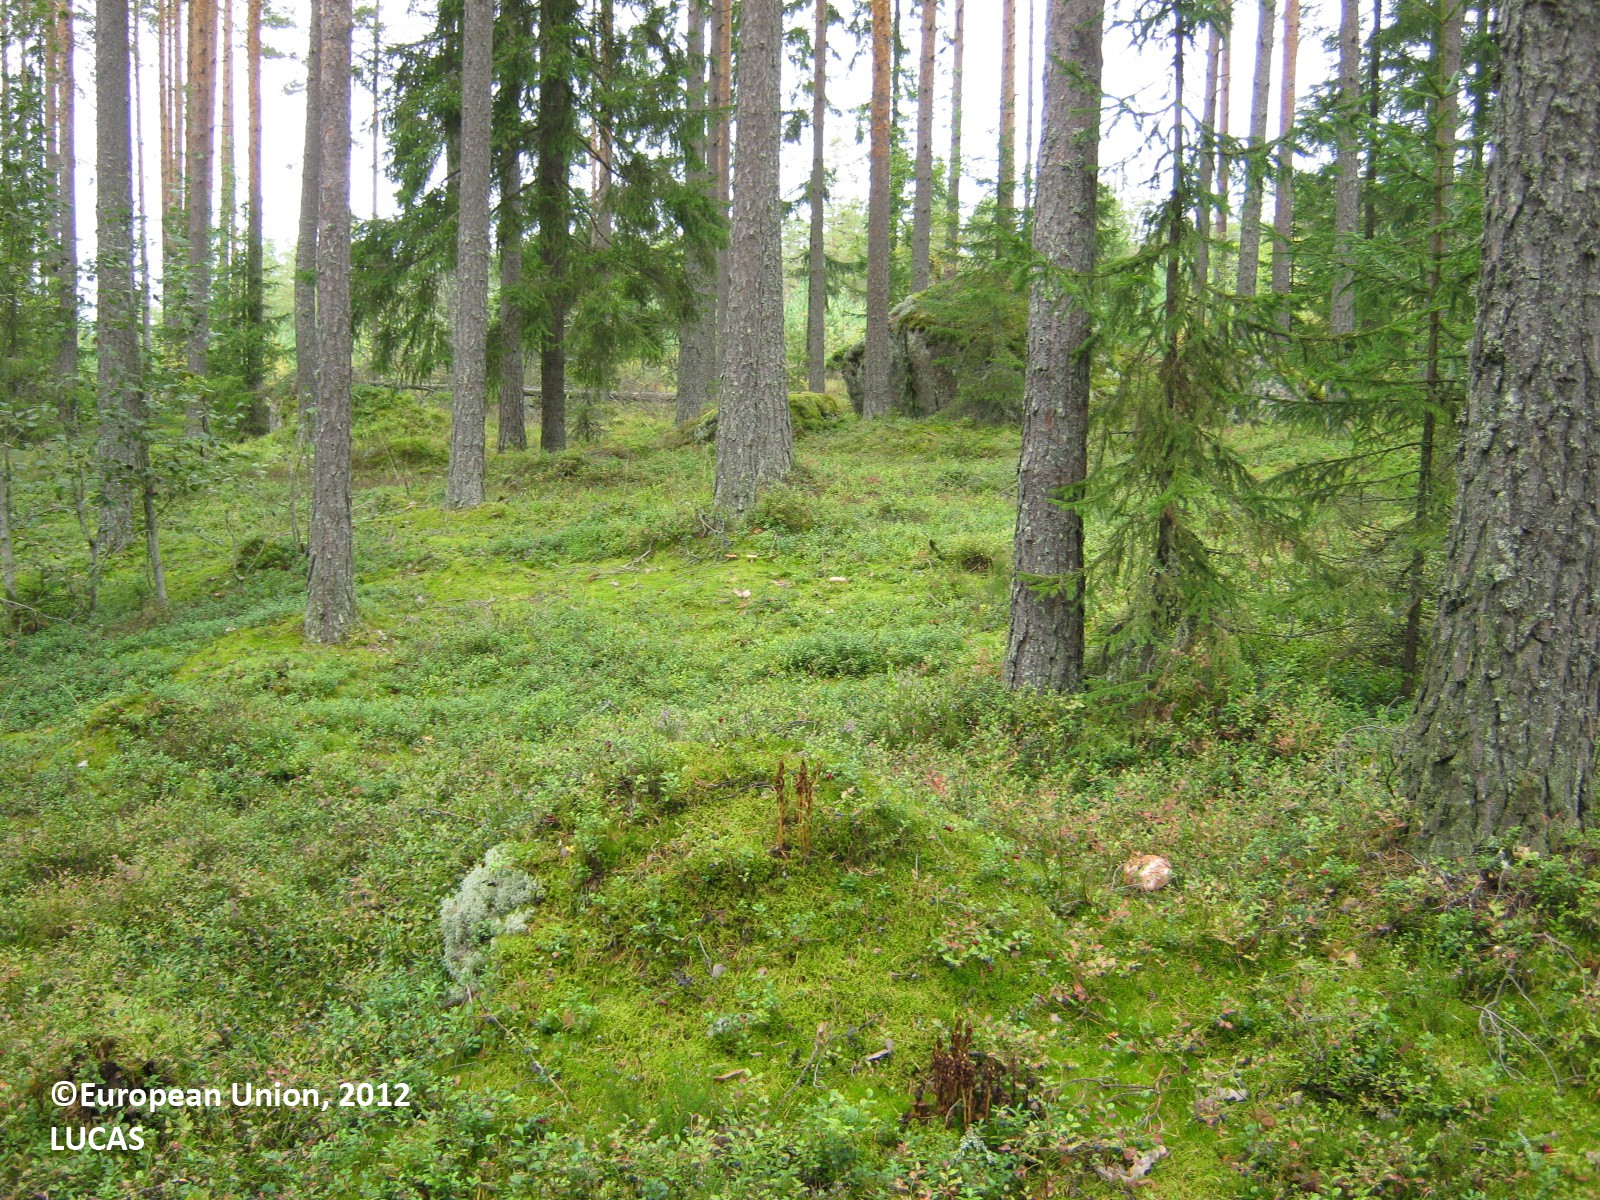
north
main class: Woodland
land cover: Other coniferous woodland
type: boreal forest
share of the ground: 50 - 75 %
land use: Forestry
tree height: > 5 m
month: September
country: FI
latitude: 60.6415
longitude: 27.6906
